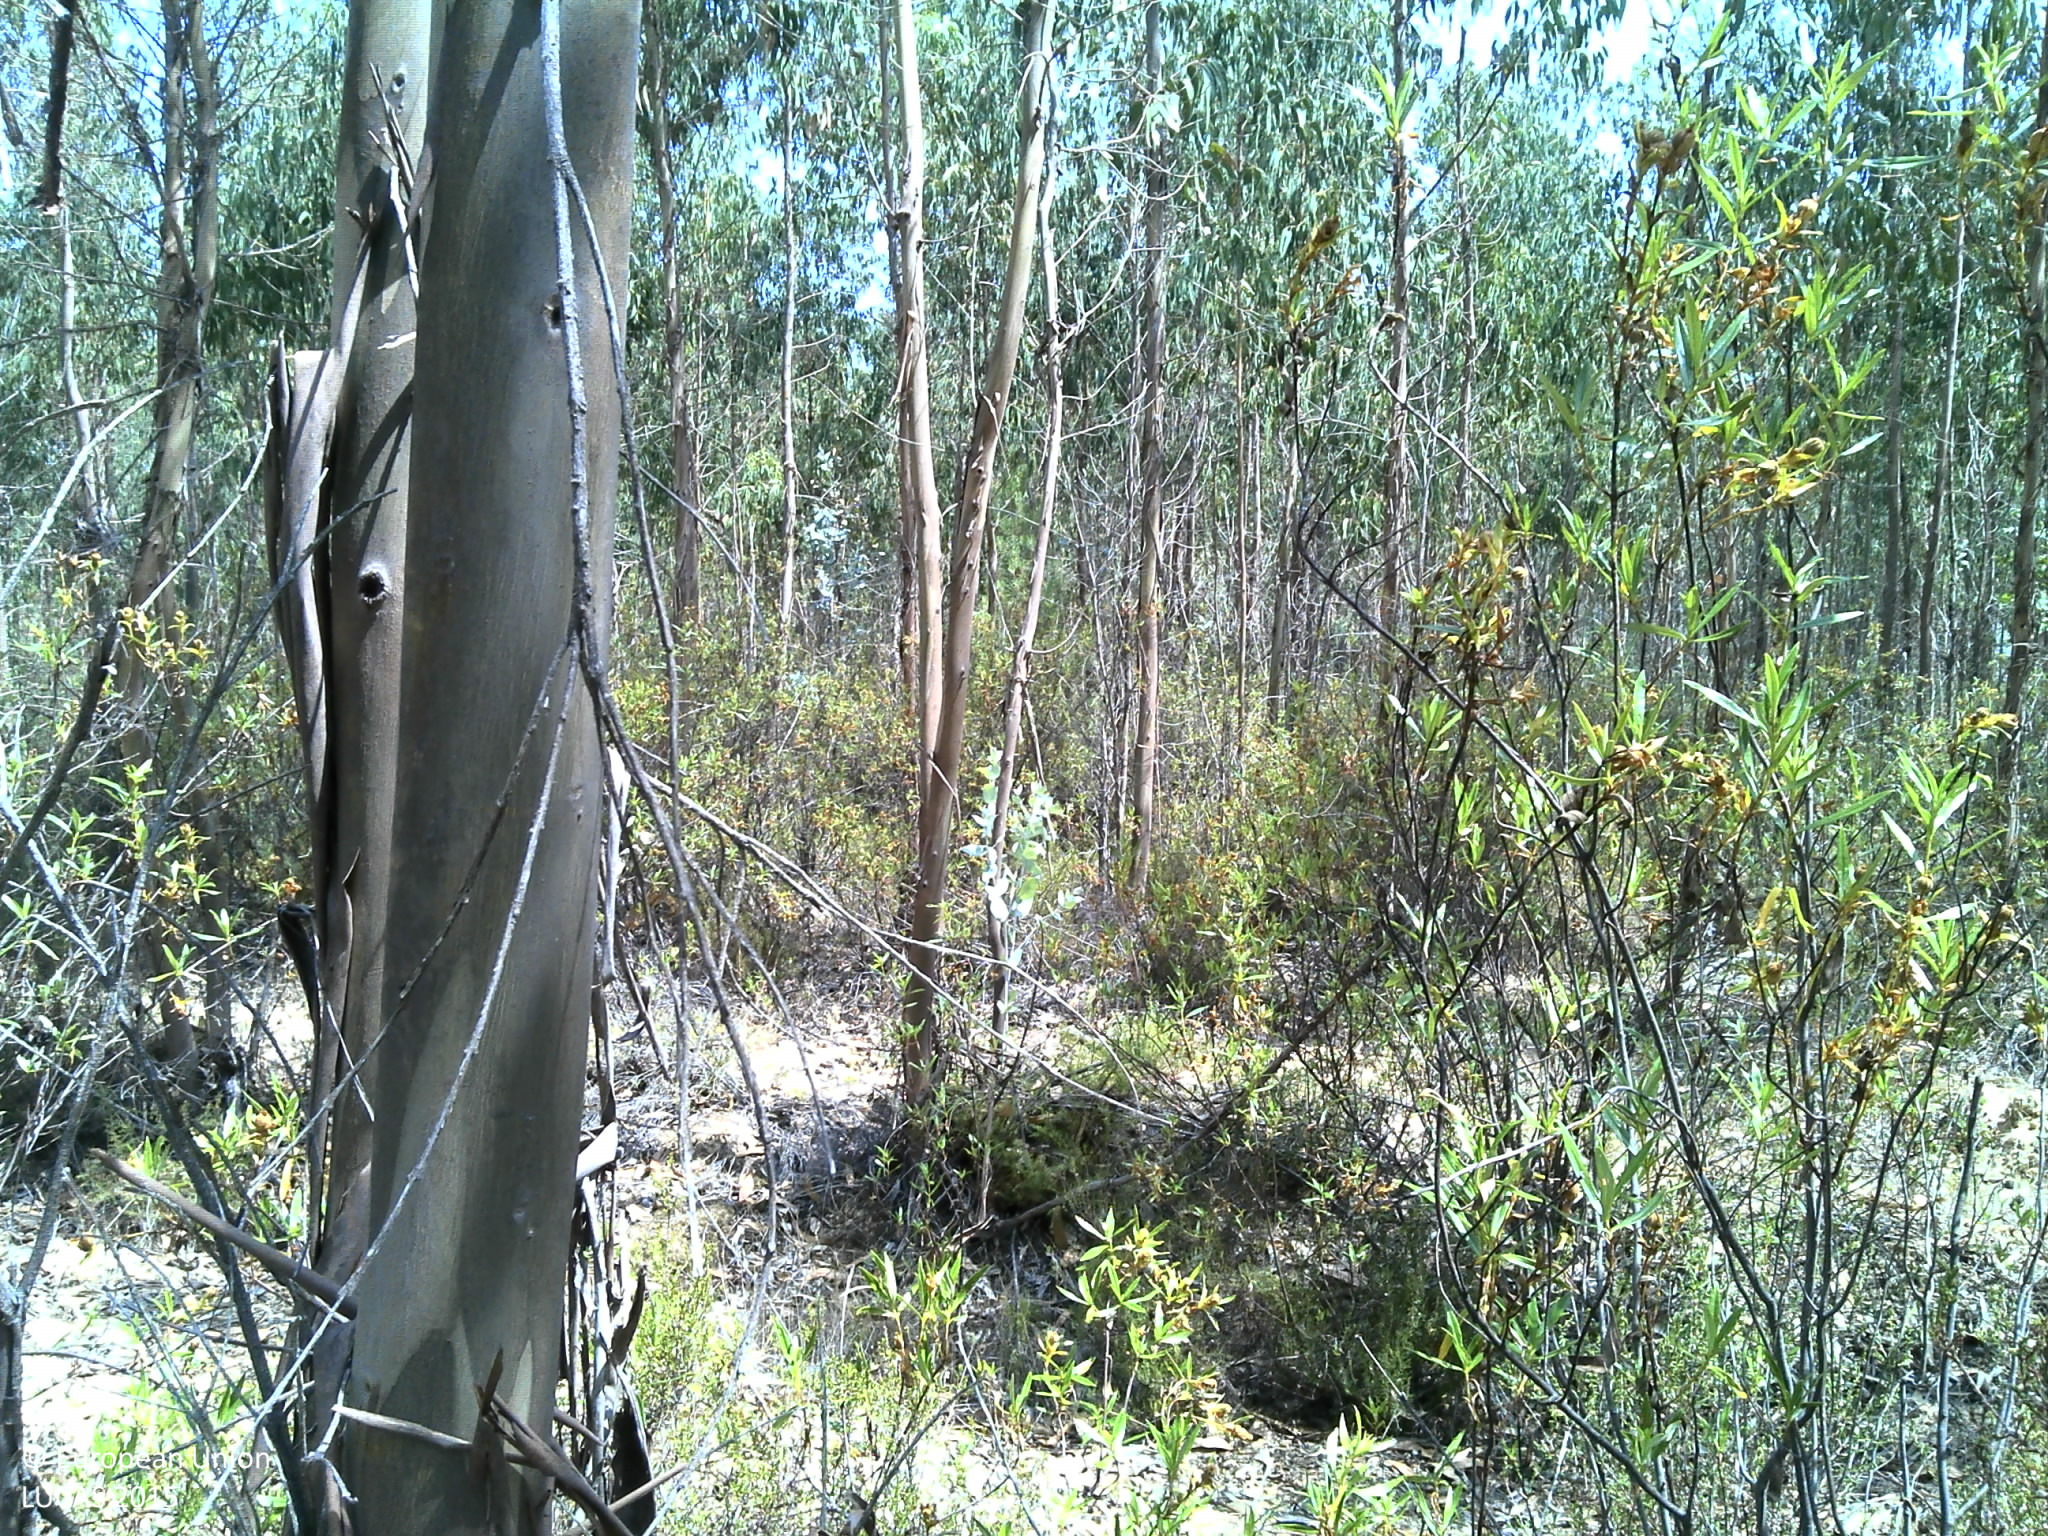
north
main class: Woodland
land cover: Broadleaved woodland
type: exotic forest
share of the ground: 25 - 50 %
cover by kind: unconsolidated bare surface 35 %, broadleaved forest trees 30 %, shrubs 25 %, consolidated bare surface 10 %
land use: Forestry
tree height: > 5 m
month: July
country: PT
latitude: 39.5584
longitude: -8.0432
